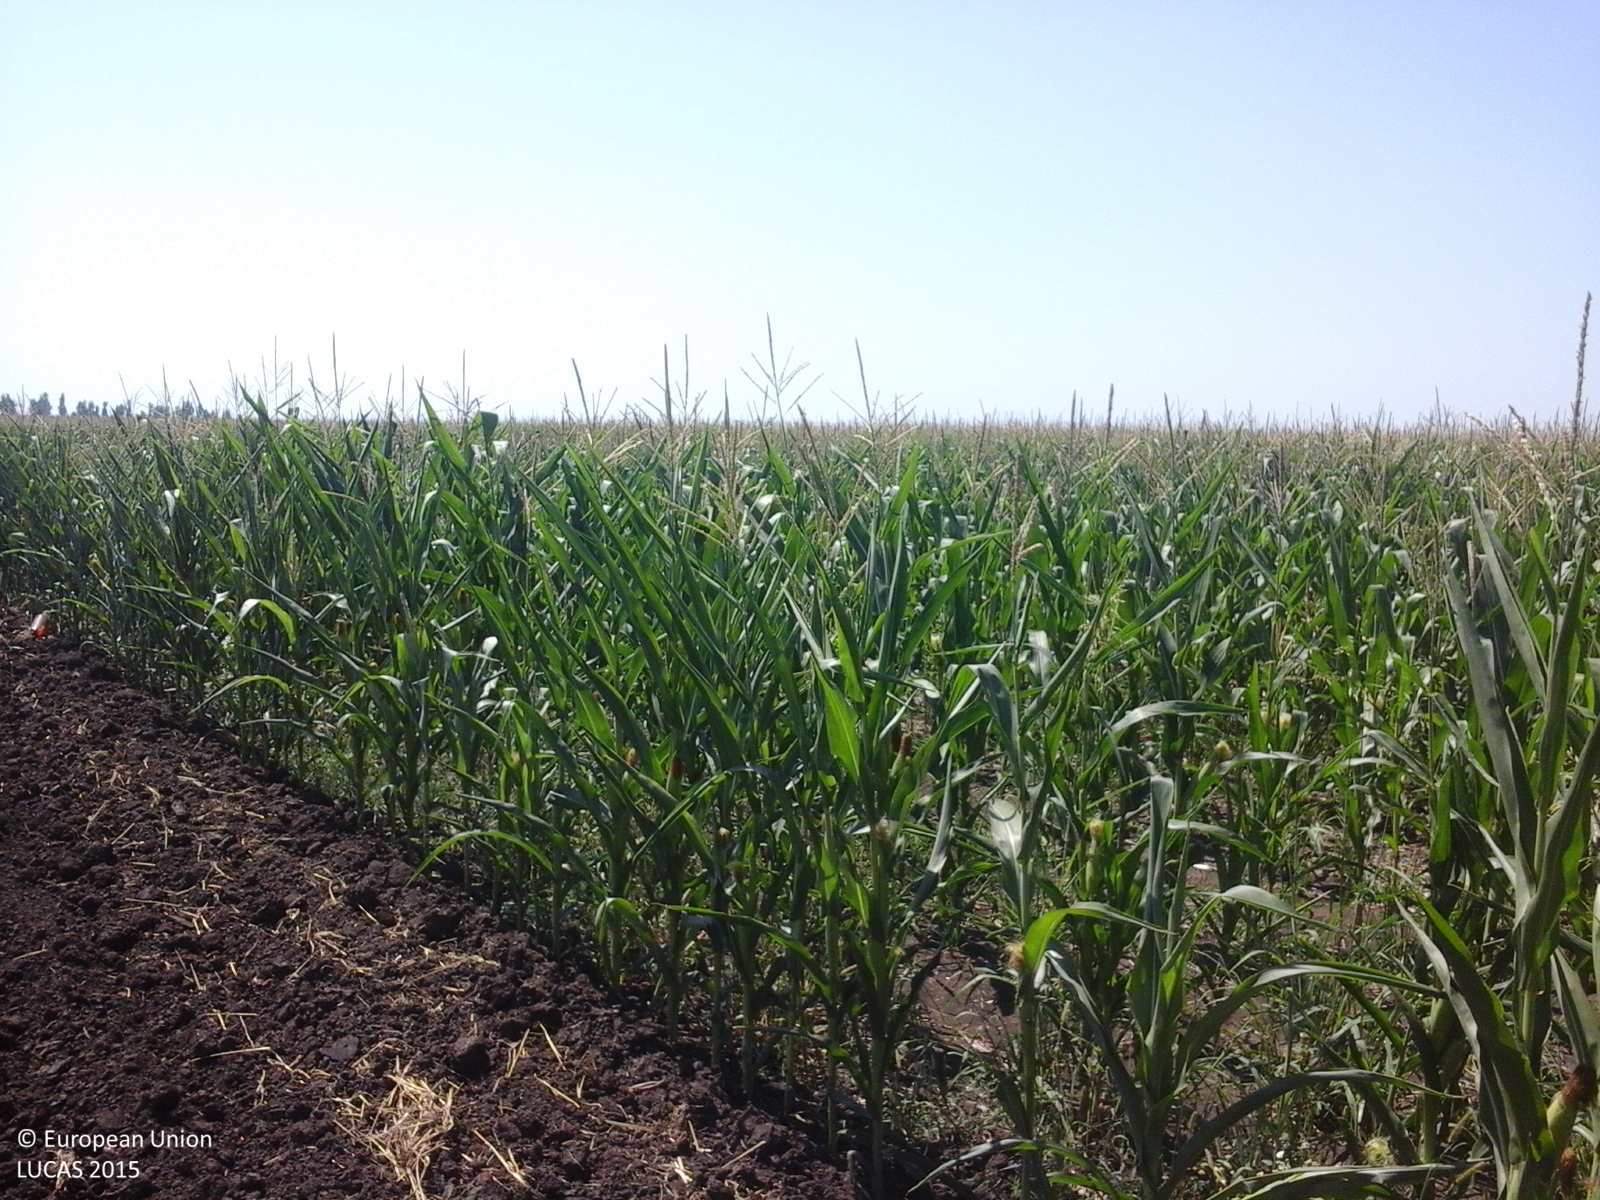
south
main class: Cropland
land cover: Maize
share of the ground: > 75 %
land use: Agriculture (excluding fallow land and kitchen gardens)
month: July
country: RO
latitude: 44.9740
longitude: 26.5684
